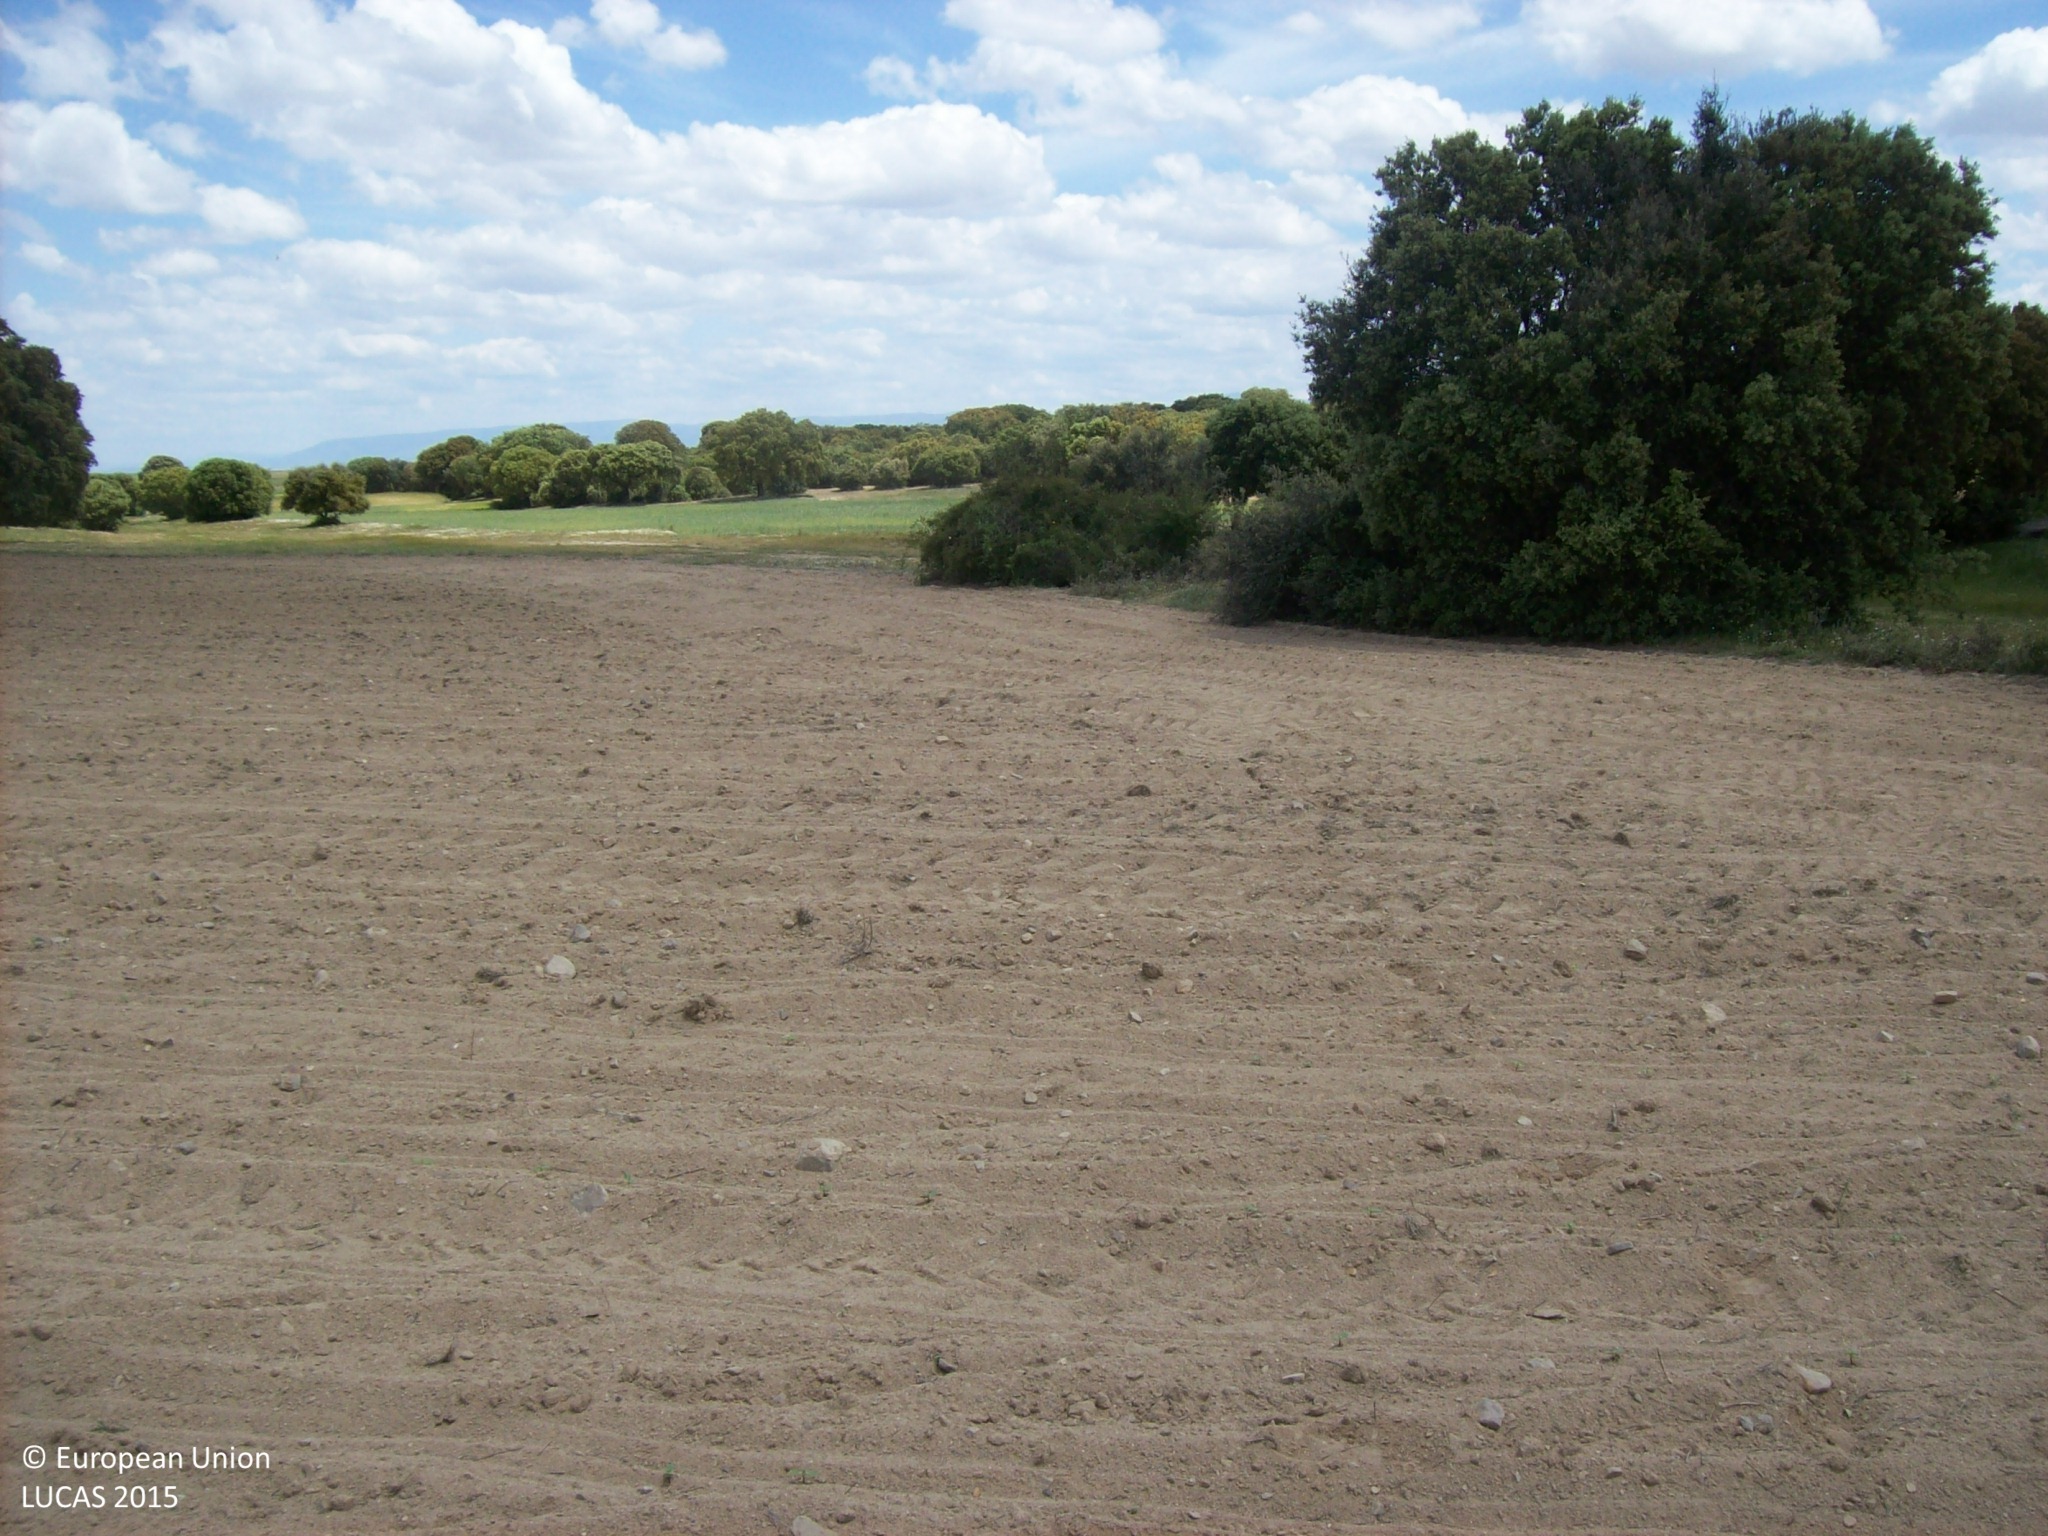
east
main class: Cropland
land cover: Sunflower
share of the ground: < 10 %
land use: Agriculture (excluding fallow land and kitchen gardens)
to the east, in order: Sunflower; Lines of trees; Grassland with sparse tree/shrub cover; Tracks; Grassland with sparse tree/shrub cover; Common wheat; Broadleaved woodland
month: May
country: ES
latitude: 40.8753
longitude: -4.4722
